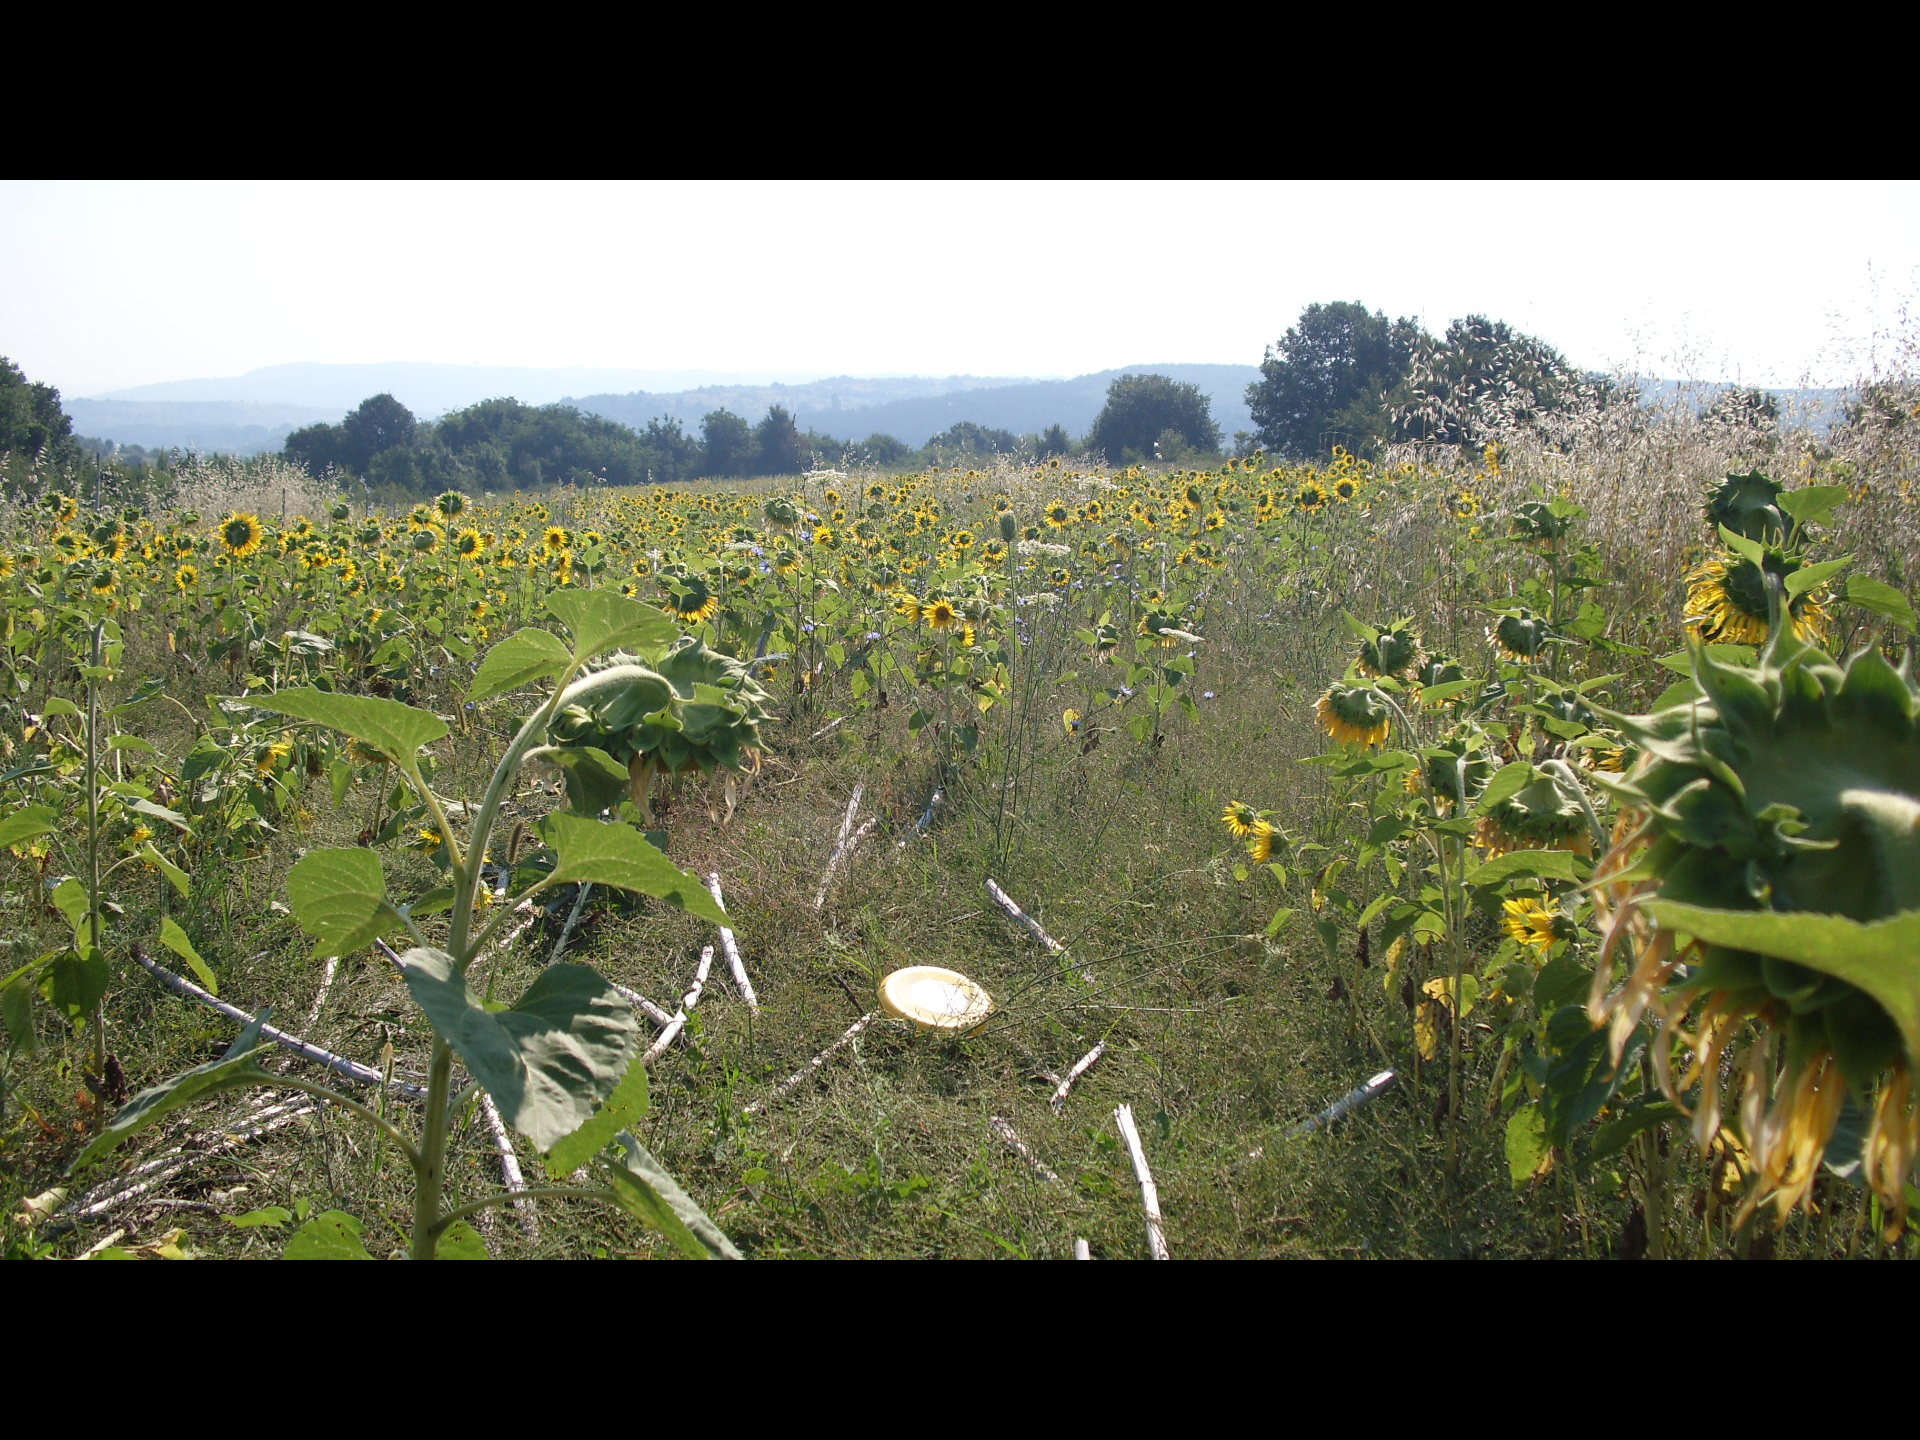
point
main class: Grassland
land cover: Spontaneously vegetated surfaces
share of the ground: > 75 %
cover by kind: herbaceous plants 100 %
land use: Fallow land
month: July
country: BG
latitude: 43.7436
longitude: 22.8898
